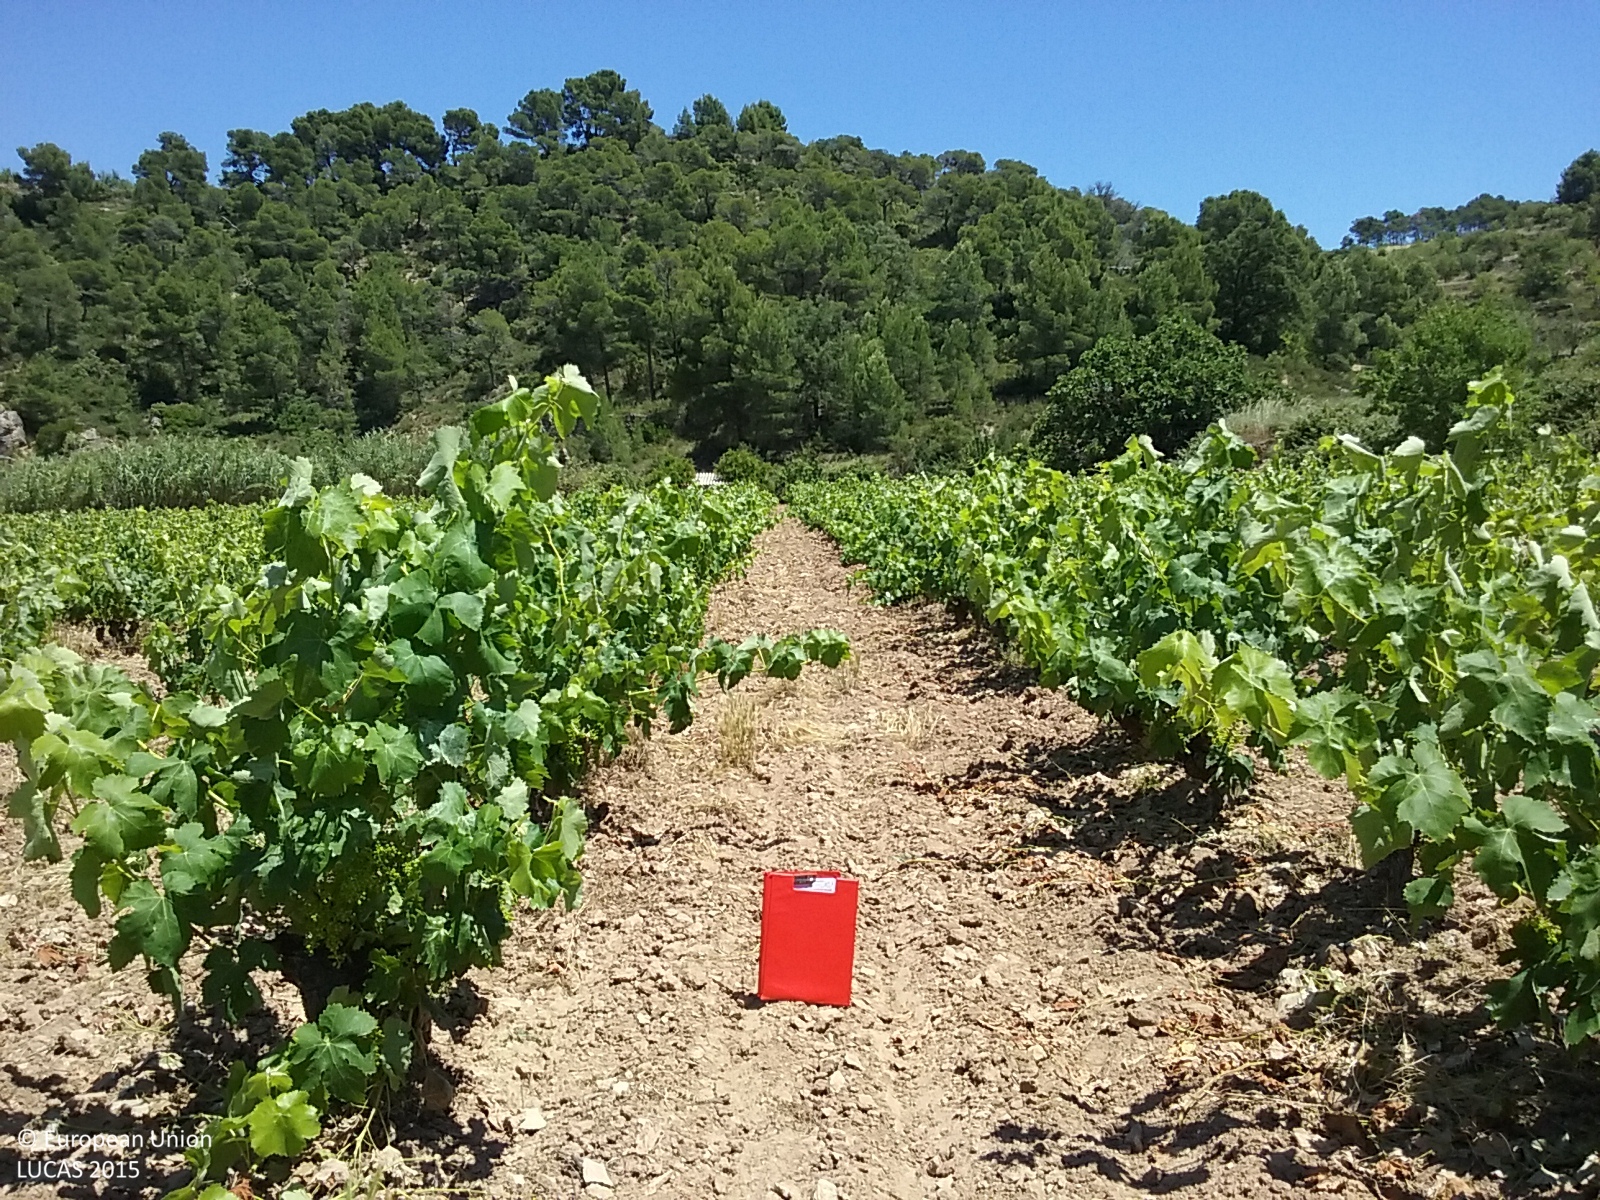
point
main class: Cropland
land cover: Vineyards
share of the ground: < 10 %
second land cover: Other bare soil
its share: > 75 %
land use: Agriculture (excluding fallow land and kitchen gardens)
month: June
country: ES
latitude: 41.1043
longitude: 0.3816
